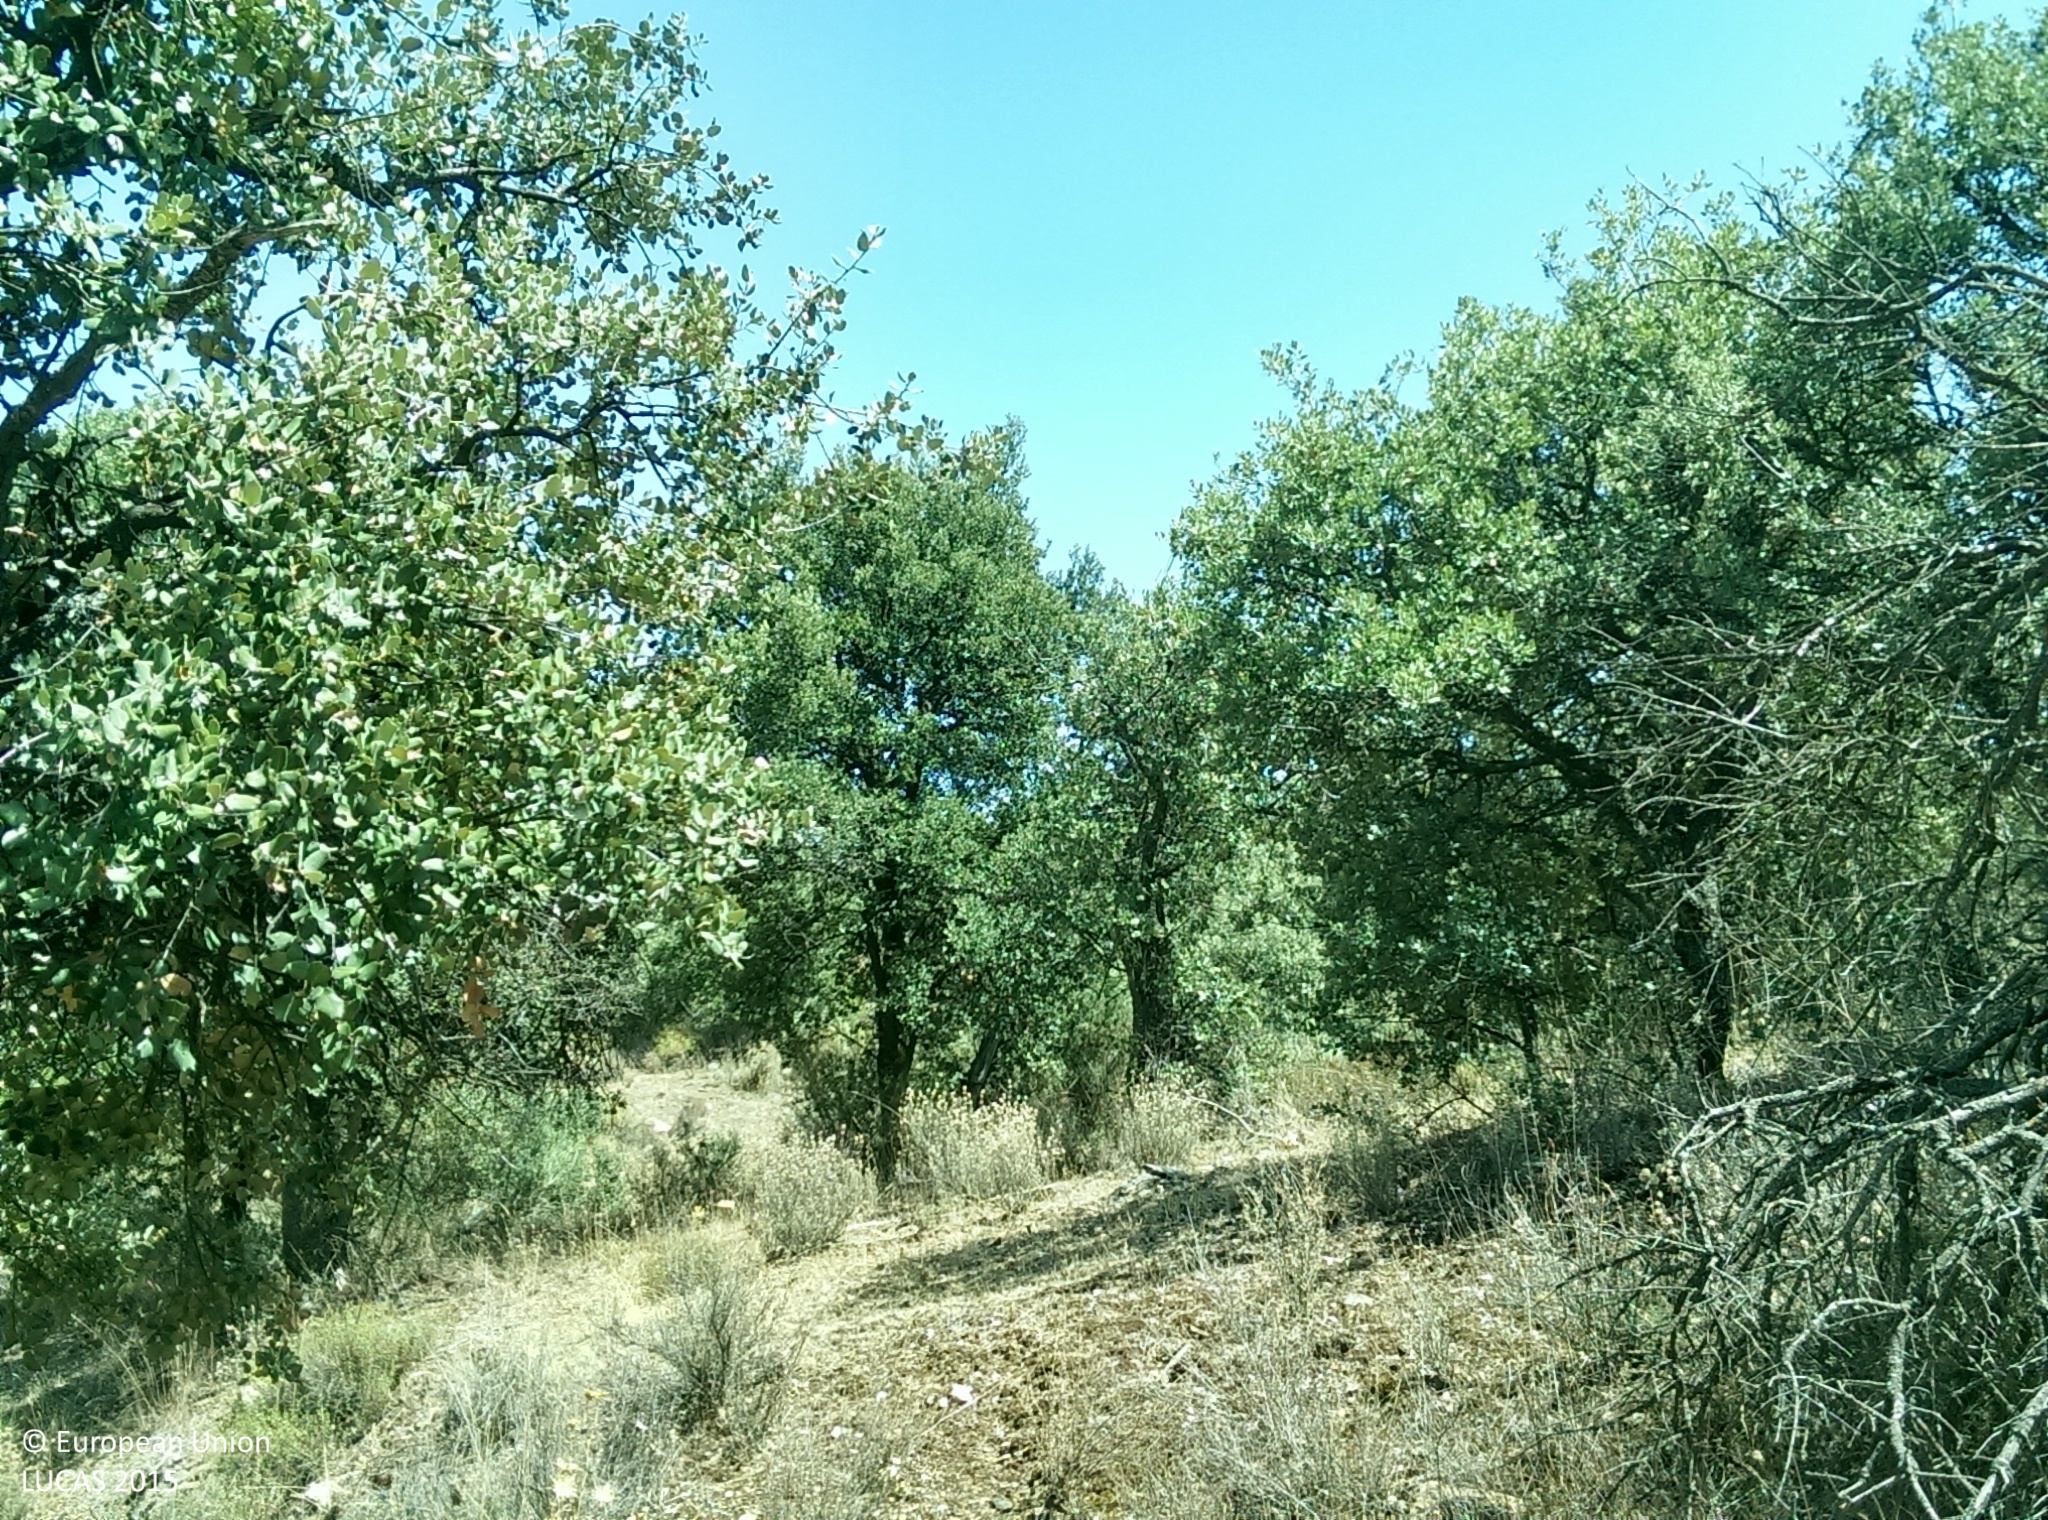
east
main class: Woodland
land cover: Broadleaved woodland
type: broadleaved evergreen forest
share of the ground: 25 - 50 %
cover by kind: broadleaved forest trees 45 %, shrubs 25 %, herbaceous plants 20 %, unconsolidated bare surface 10 %
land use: Semi-natural and natural areas not in use
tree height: < 5 m
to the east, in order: Broadleaved woodland; Olive groves
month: July
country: ES
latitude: 37.2436
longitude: -3.2102
